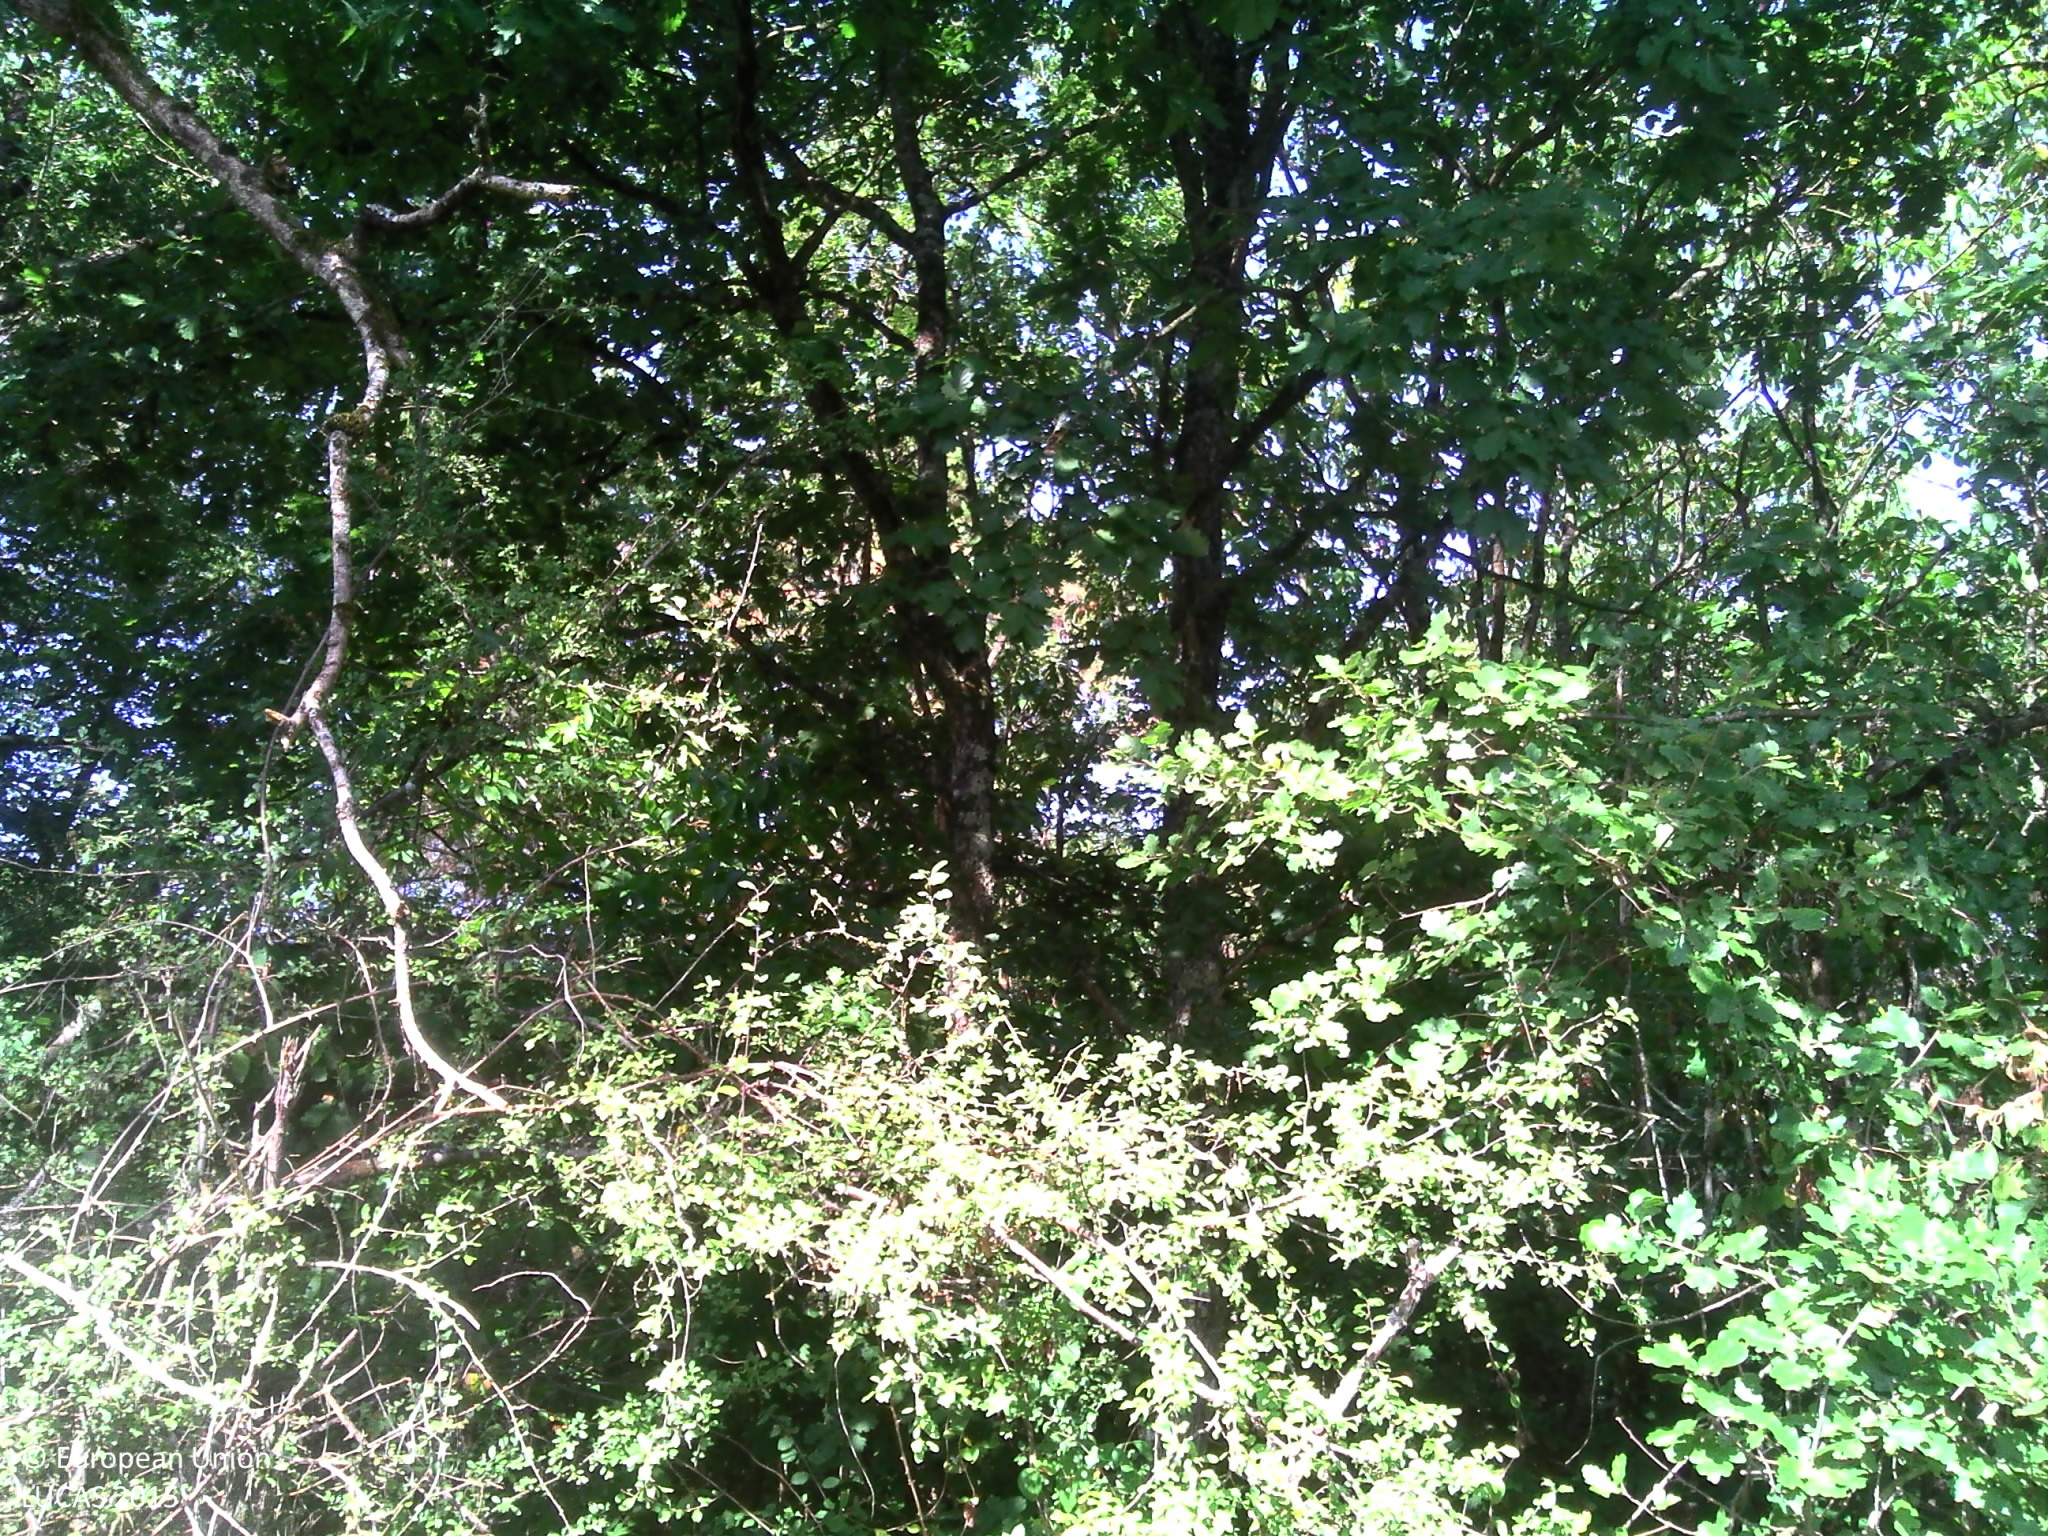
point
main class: Woodland
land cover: Pine dominated mixed woodland
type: mesophytic deciduous forest
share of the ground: > 75 %
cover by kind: broadleaved forest trees 50 %, coniferous forest trees 25 %, shrubs 10 %, herbaceous plants 10 %, lichens and mosses 5 %
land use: Forestry
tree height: > 5 m
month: July
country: FR
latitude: 47.0660
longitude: 0.4599
